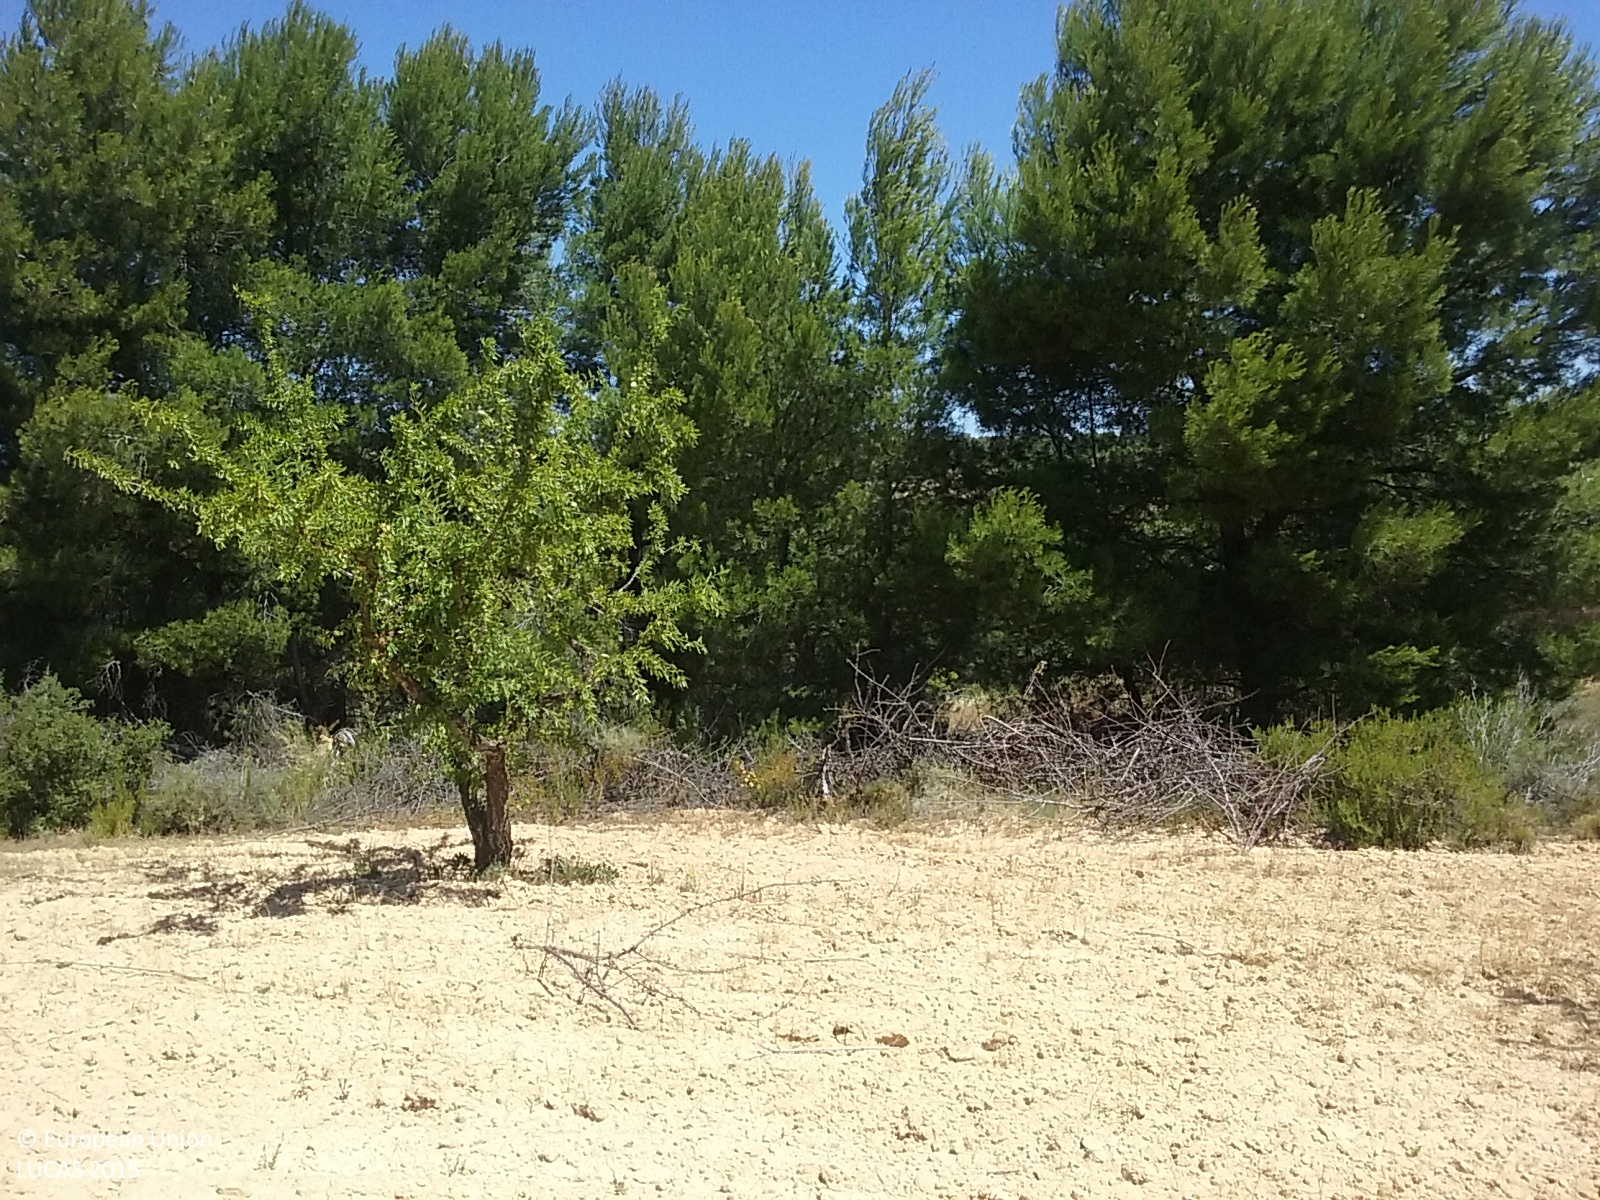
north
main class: Cropland
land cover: Nuts trees
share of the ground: 25 - 50 %
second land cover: Spontaneously vegetated surfaces
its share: 10 - 25 %
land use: Agriculture (excluding fallow land and kitchen gardens)
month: June
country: ES
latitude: 41.1153
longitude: 0.3081
